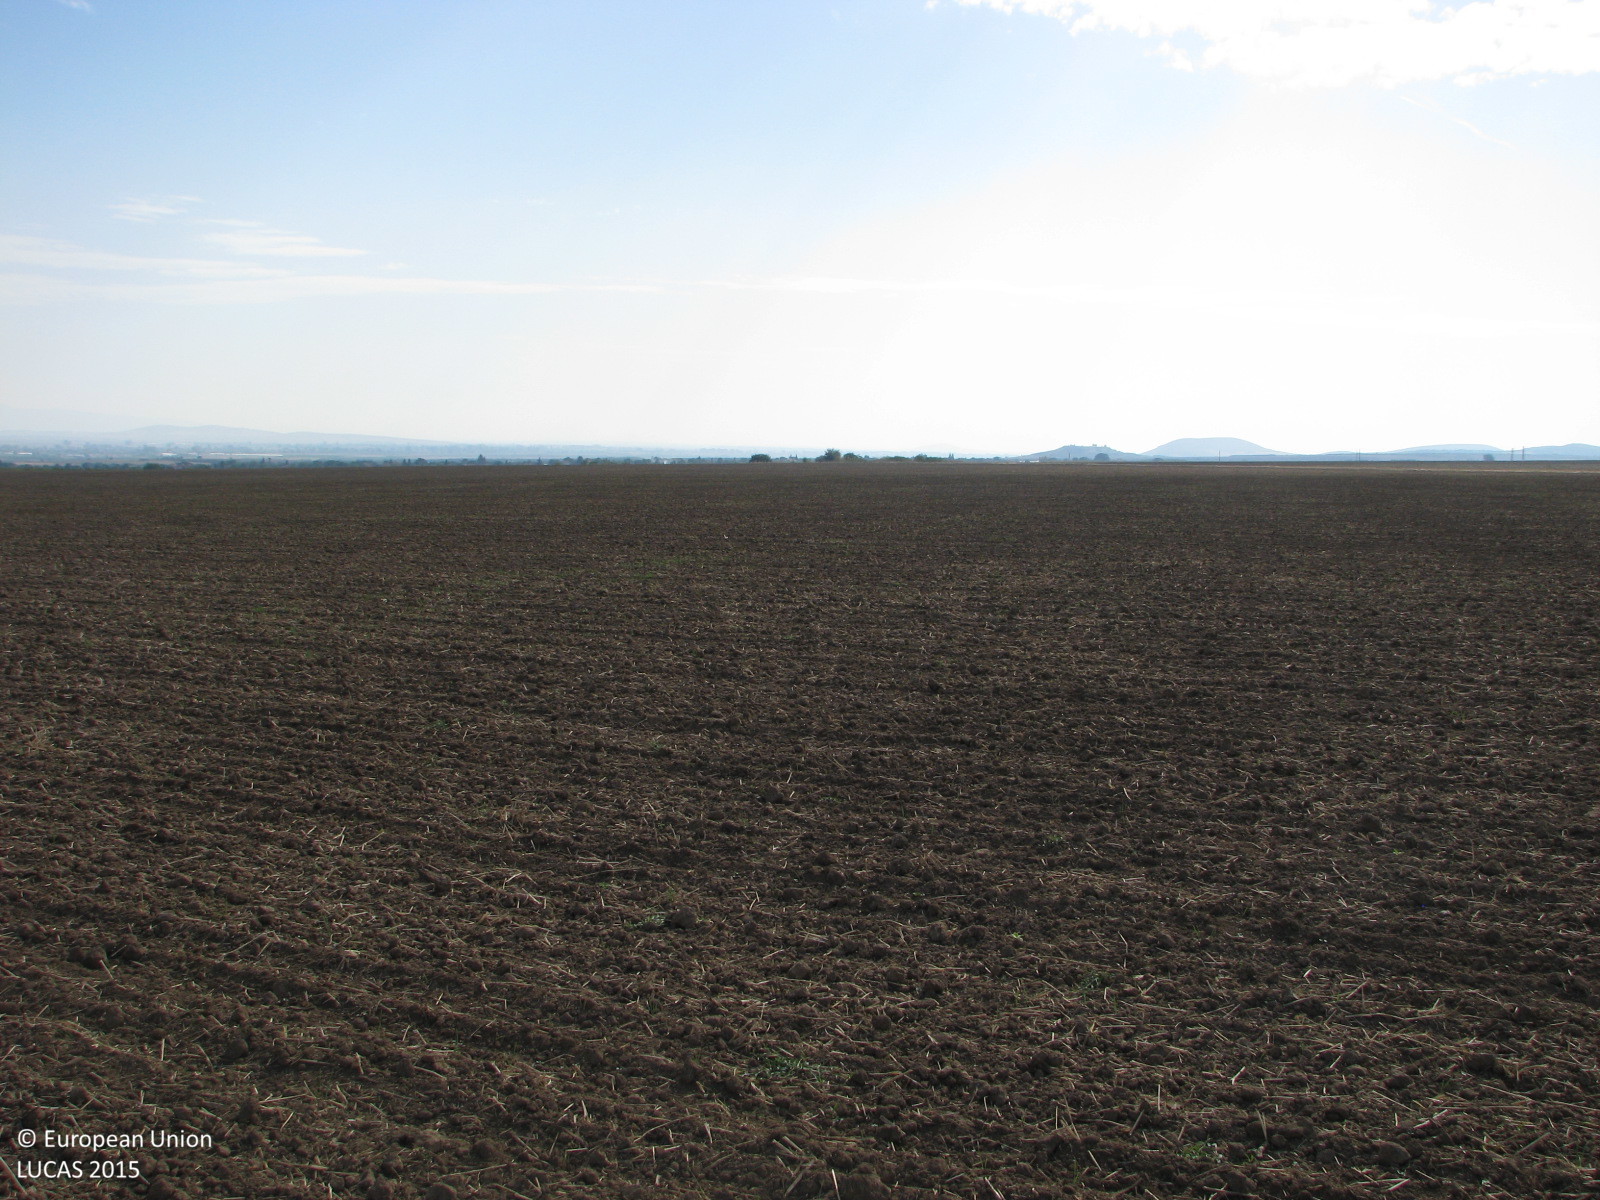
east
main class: Cropland
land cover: Common wheat
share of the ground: < 10 %
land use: Agriculture (excluding fallow land and kitchen gardens)
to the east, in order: Common wheat
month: September
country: BG
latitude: 42.5707
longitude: 26.2034
